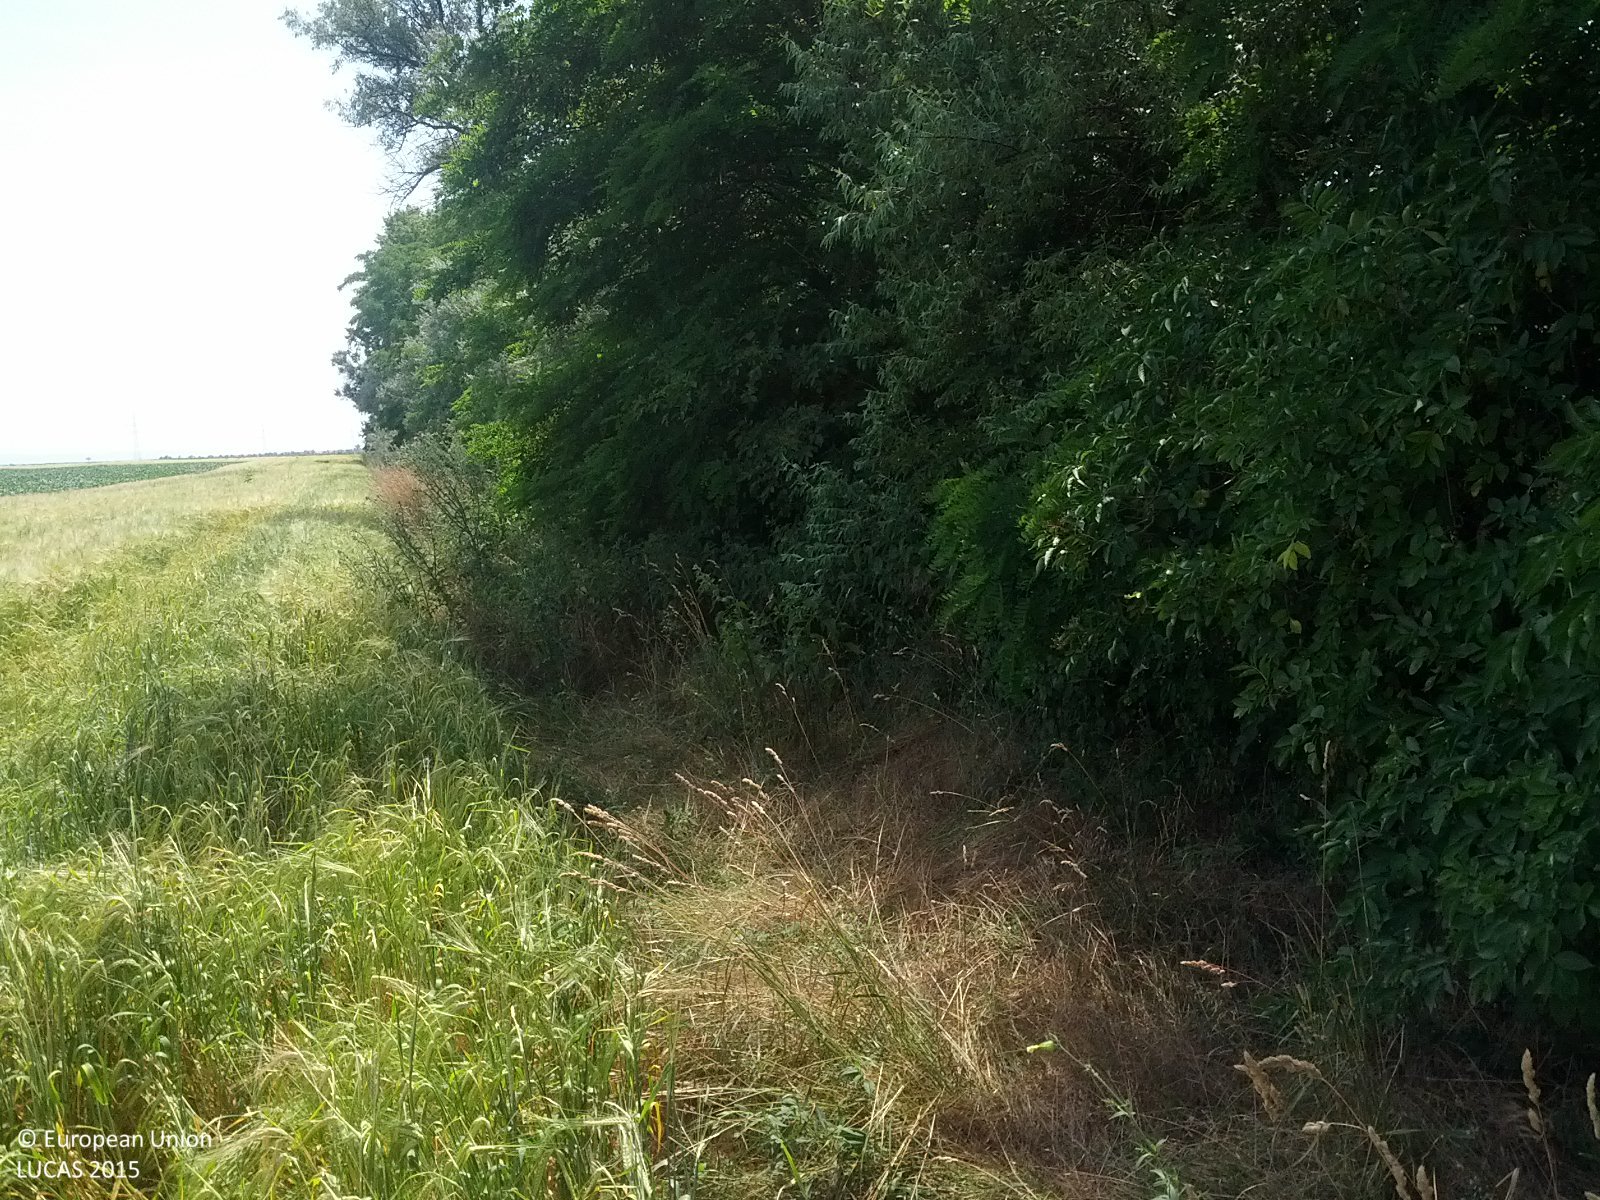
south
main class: Cropland
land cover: Barley
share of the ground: > 75 %
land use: Agriculture (excluding fallow land and kitchen gardens)
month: June
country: AT
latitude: 48.6792
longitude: 16.8393
